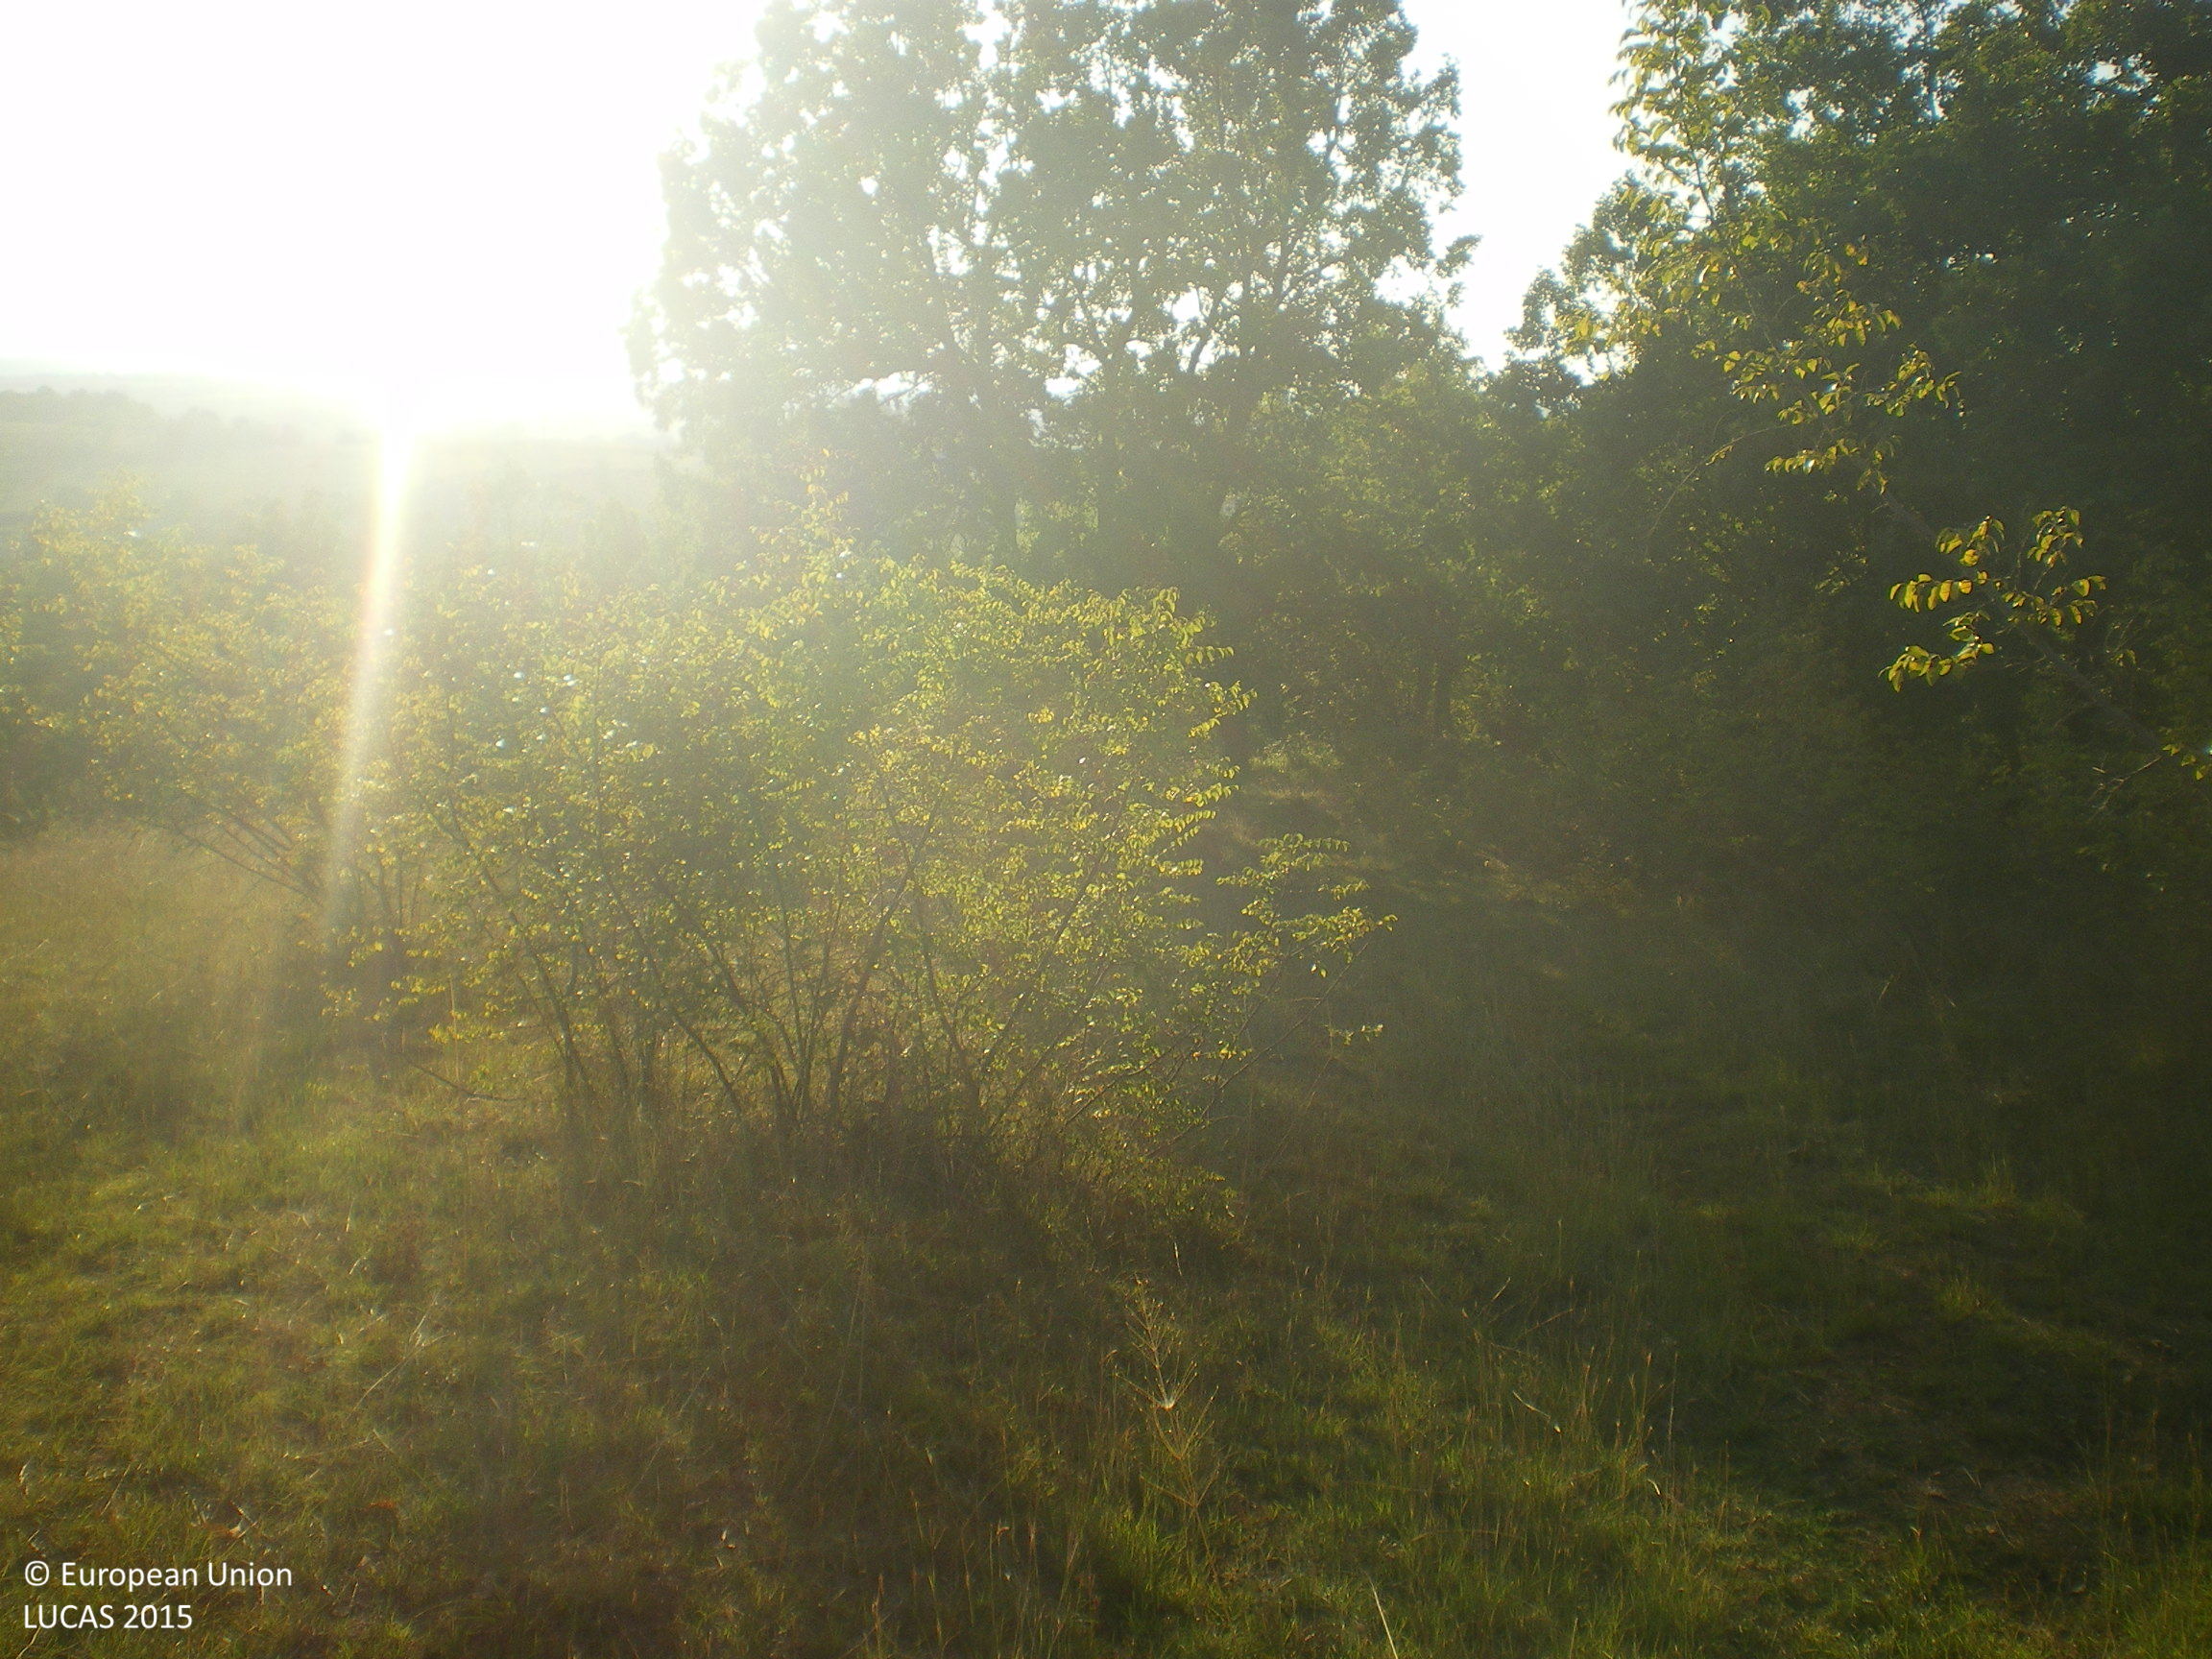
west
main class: Grassland
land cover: Grassland with sparse tree/shrub cover
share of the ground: > 75 %
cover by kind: herbaceous plants 85 %, shrubs 10 %, broadleaved forest trees 5 %
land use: Agriculture (excluding fallow land and kitchen gardens)
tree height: > 5 m
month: September
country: BG
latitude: 41.8051
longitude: 25.8234
